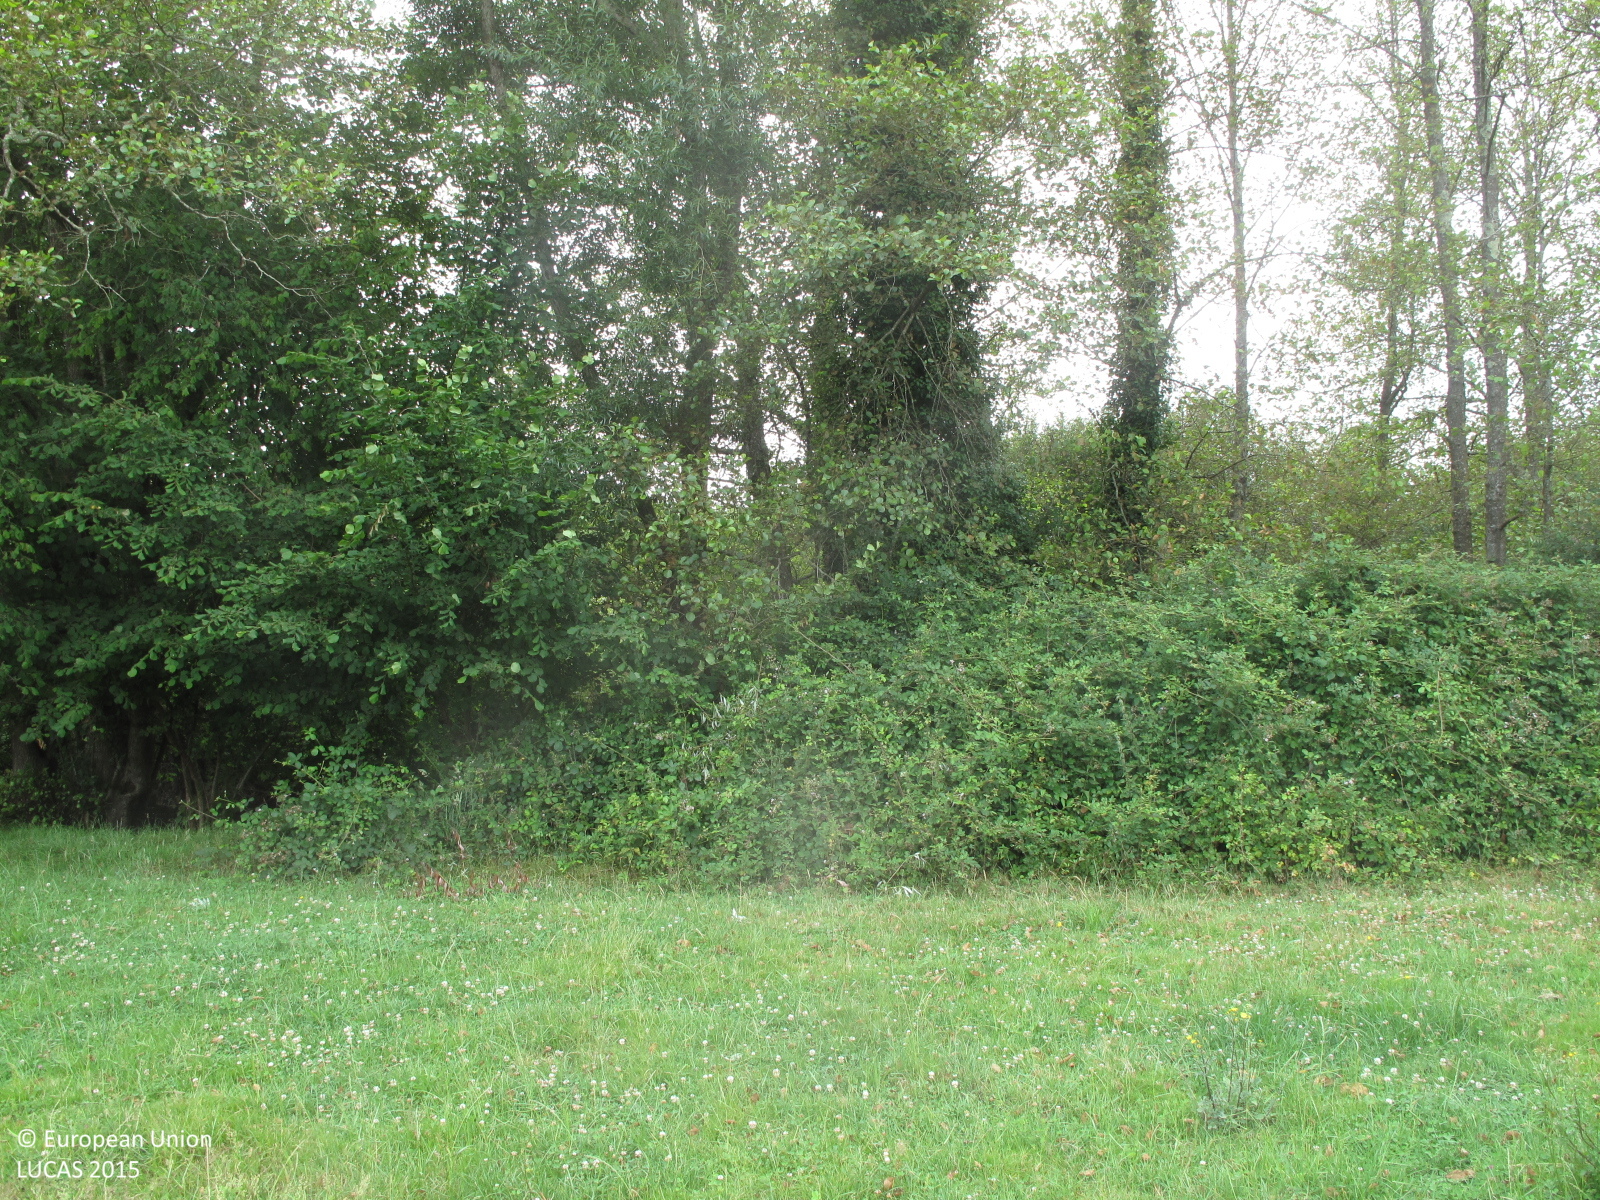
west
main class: Grassland
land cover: Grassland without tree/shrub cover
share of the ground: > 75 %
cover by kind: herbaceous plants 100 %
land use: Agriculture (excluding fallow land and kitchen gardens)
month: July
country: ES
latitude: 43.2341
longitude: -8.2379
